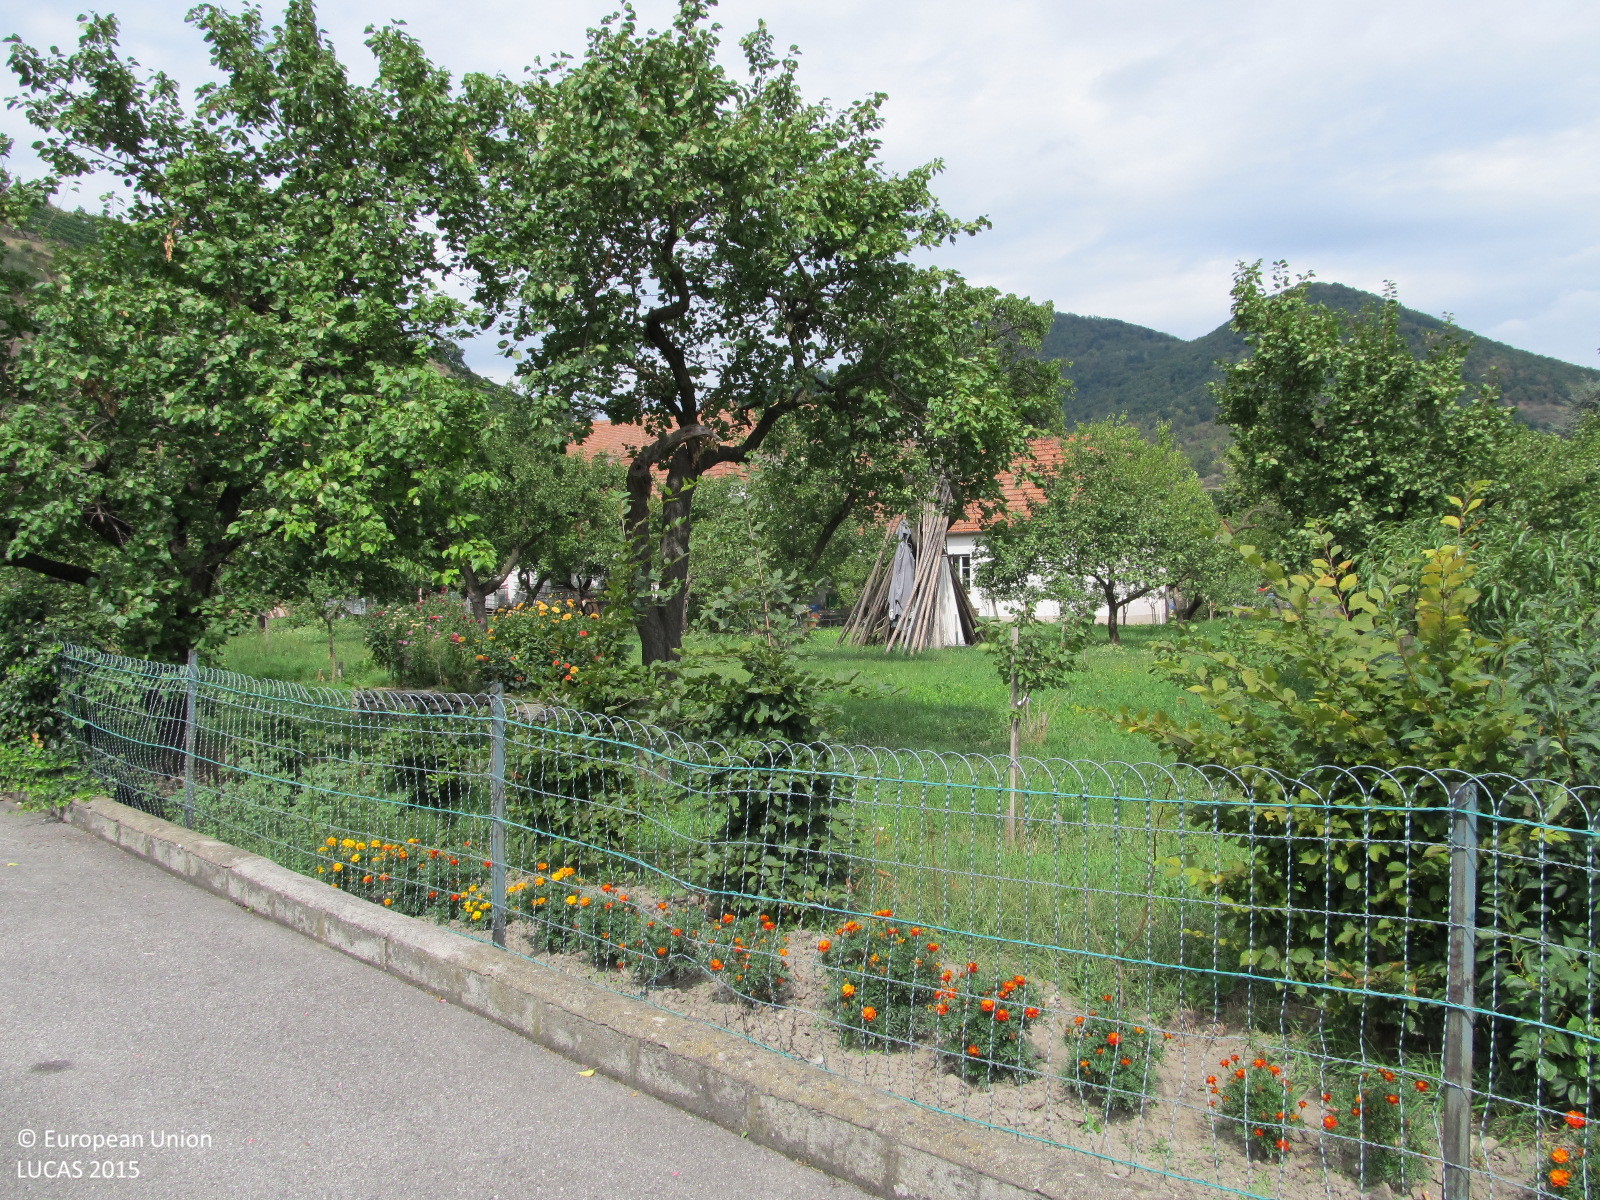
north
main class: Grassland
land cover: Grassland without tree/shrub cover
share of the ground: > 75 %
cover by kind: herbaceous plants 100 %
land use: Residential
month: September
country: AT
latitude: 48.3610
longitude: 15.4146
